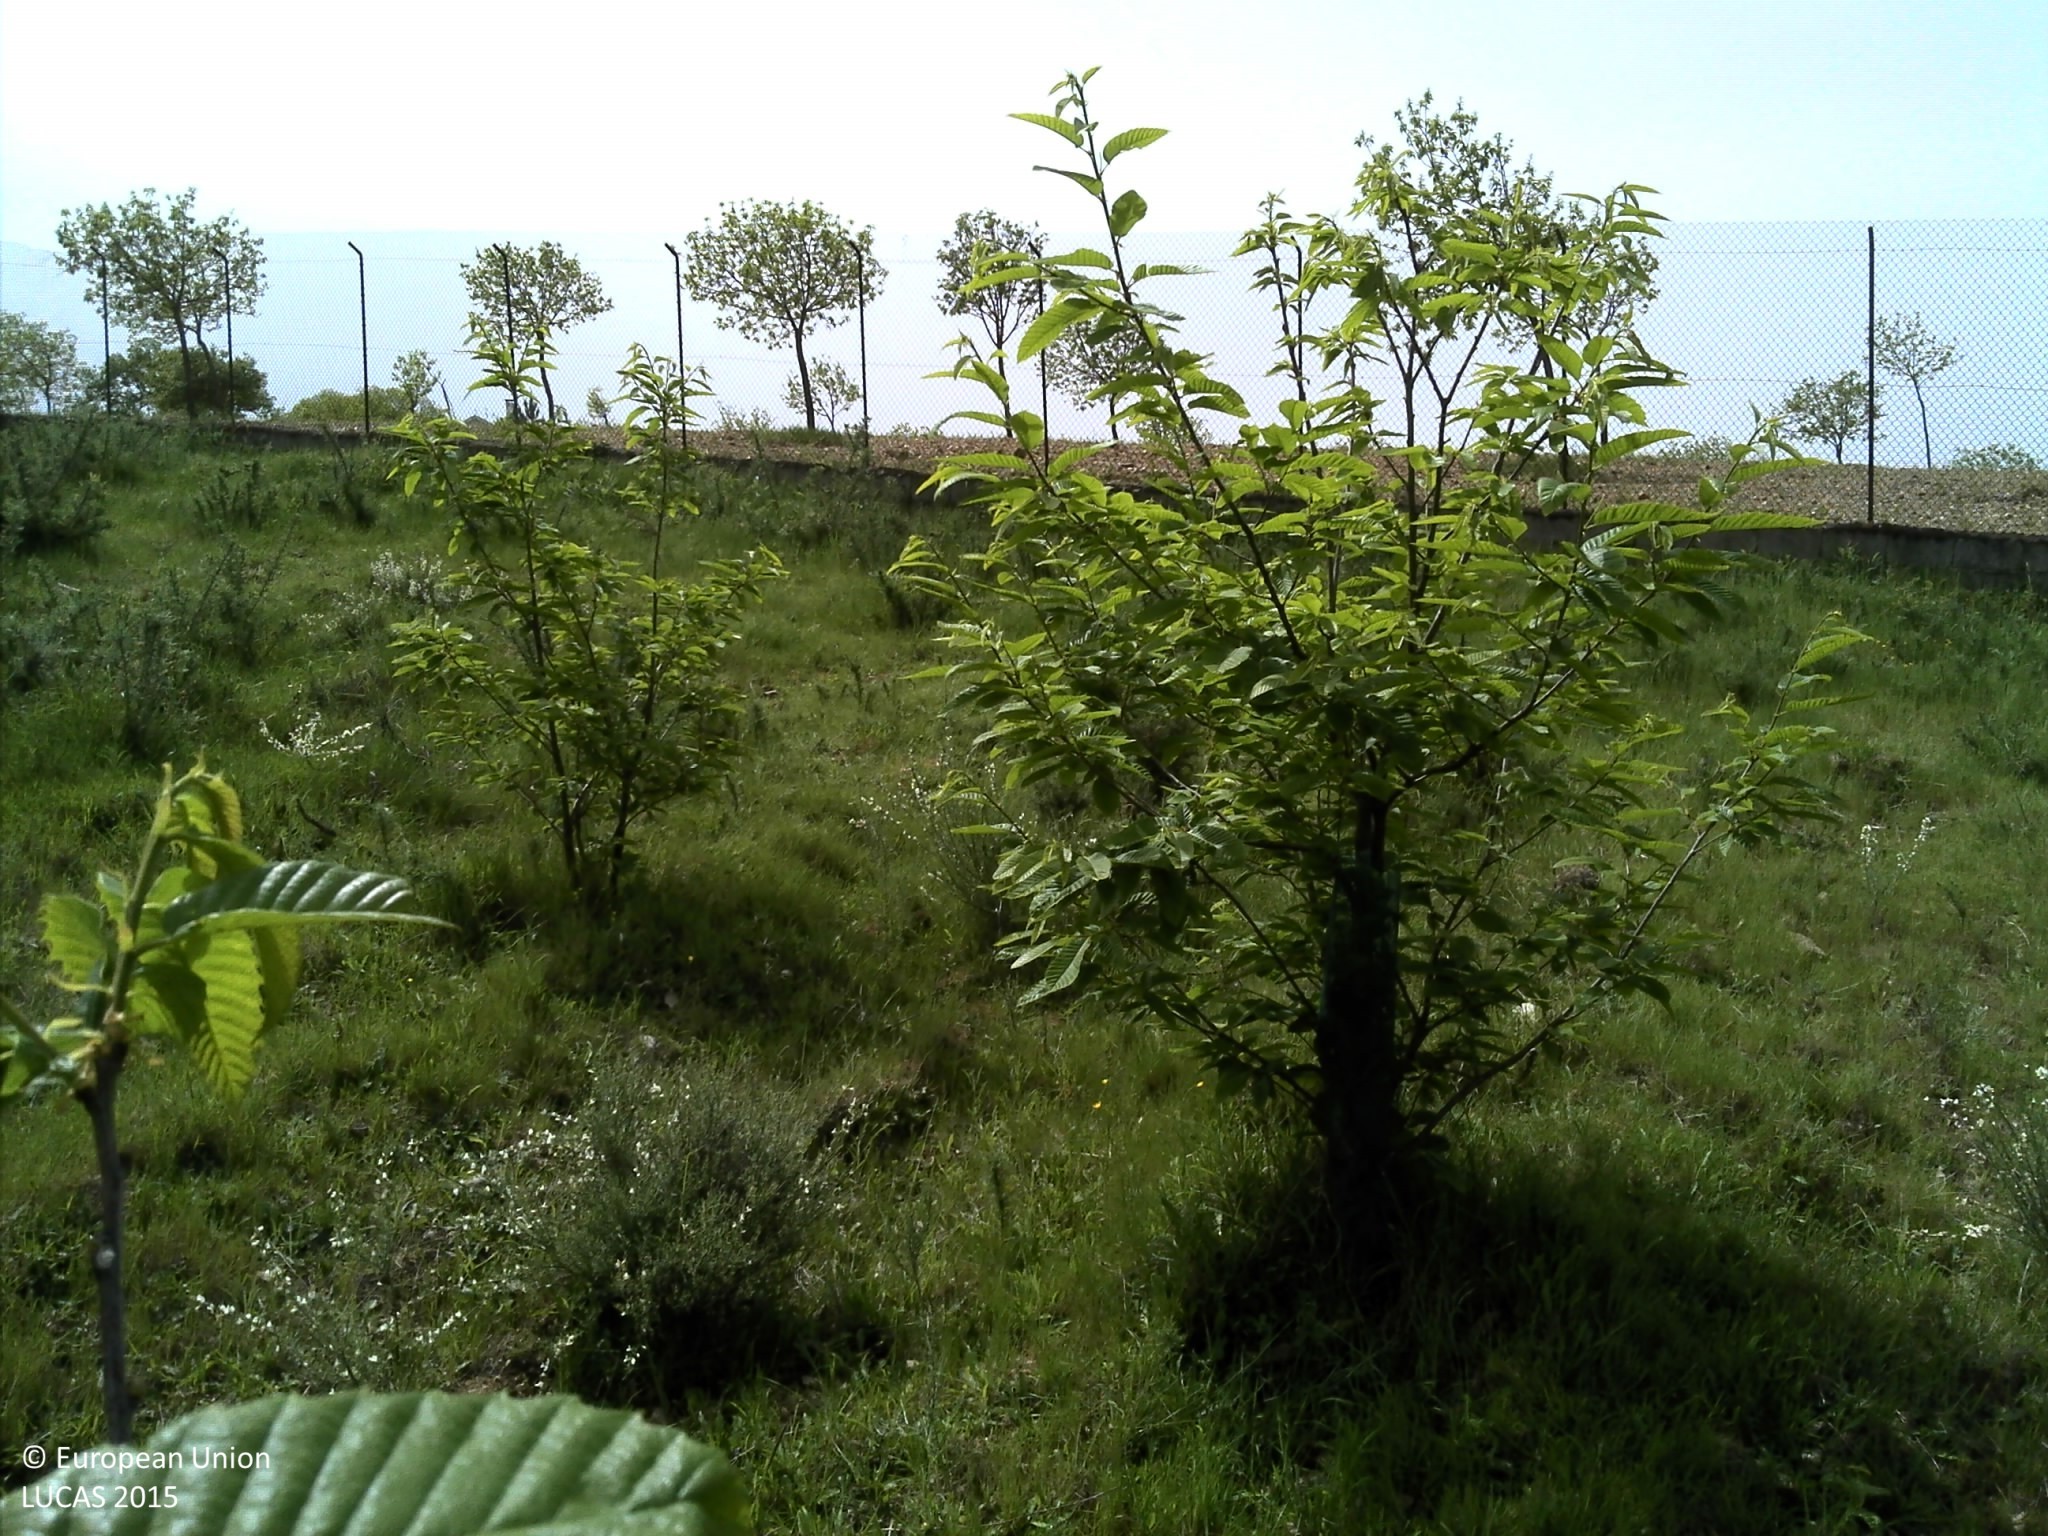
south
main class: Cropland
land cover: Nuts trees
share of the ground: 10 - 25 %
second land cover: Grassland without tree/shrub cover
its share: 25 - 50 %
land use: Agriculture (excluding fallow land and kitchen gardens)
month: May
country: PT
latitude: 41.9310
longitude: -7.1656
